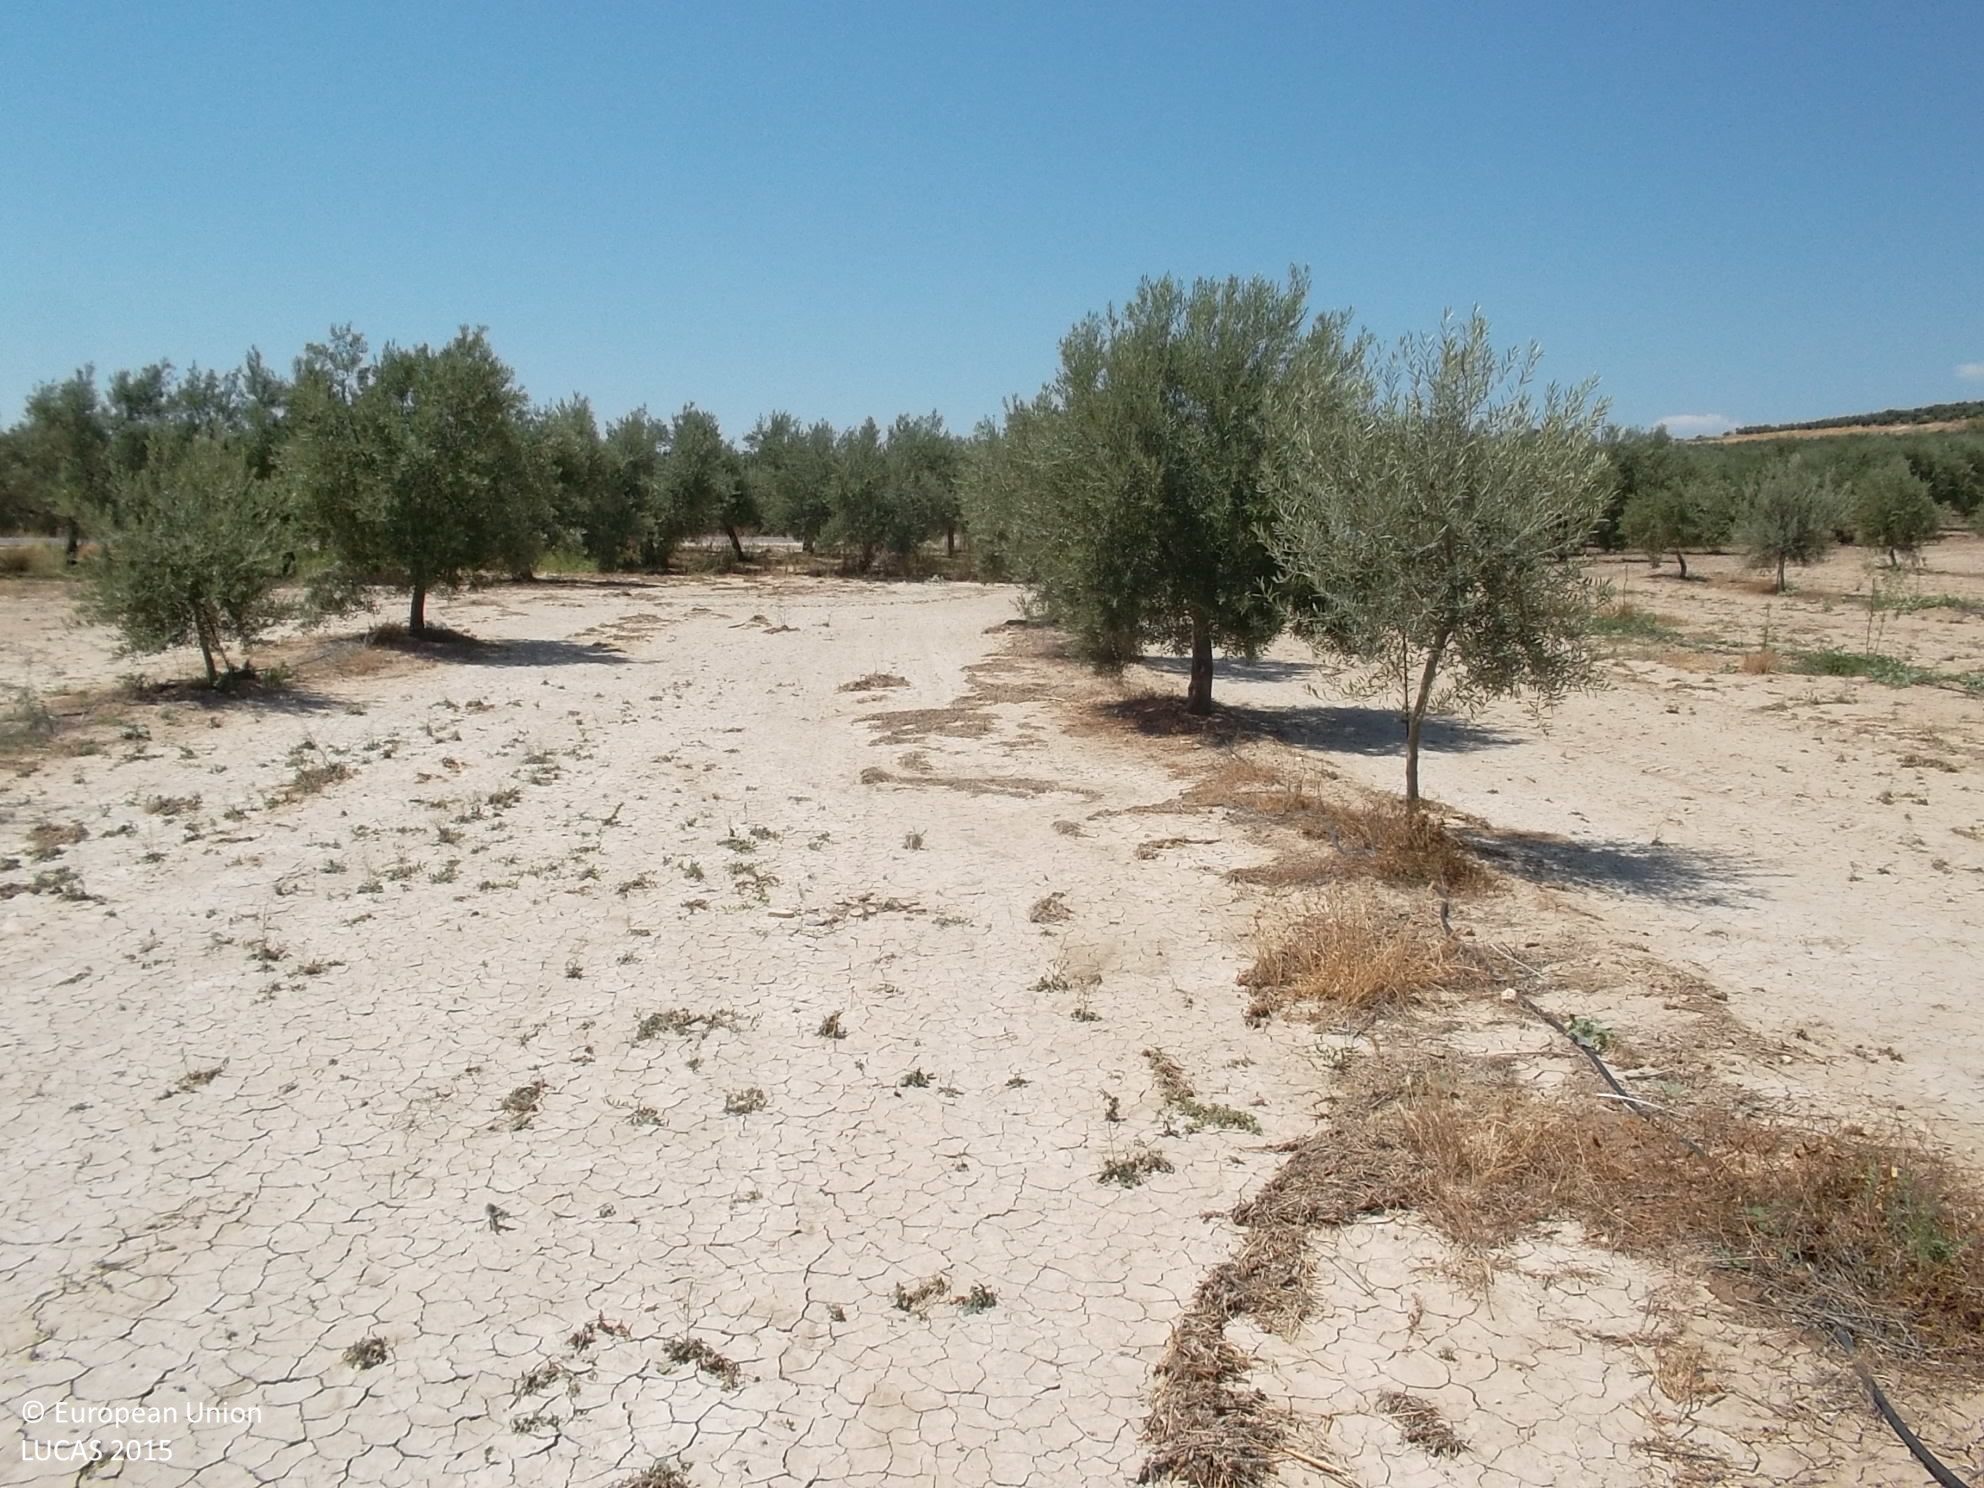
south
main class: Cropland
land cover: Olive groves
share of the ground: 25 - 50 %
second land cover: Other bare soil
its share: > 75 %
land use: Agriculture (excluding fallow land and kitchen gardens)
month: June
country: ES
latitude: 37.8454
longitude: -3.2354
